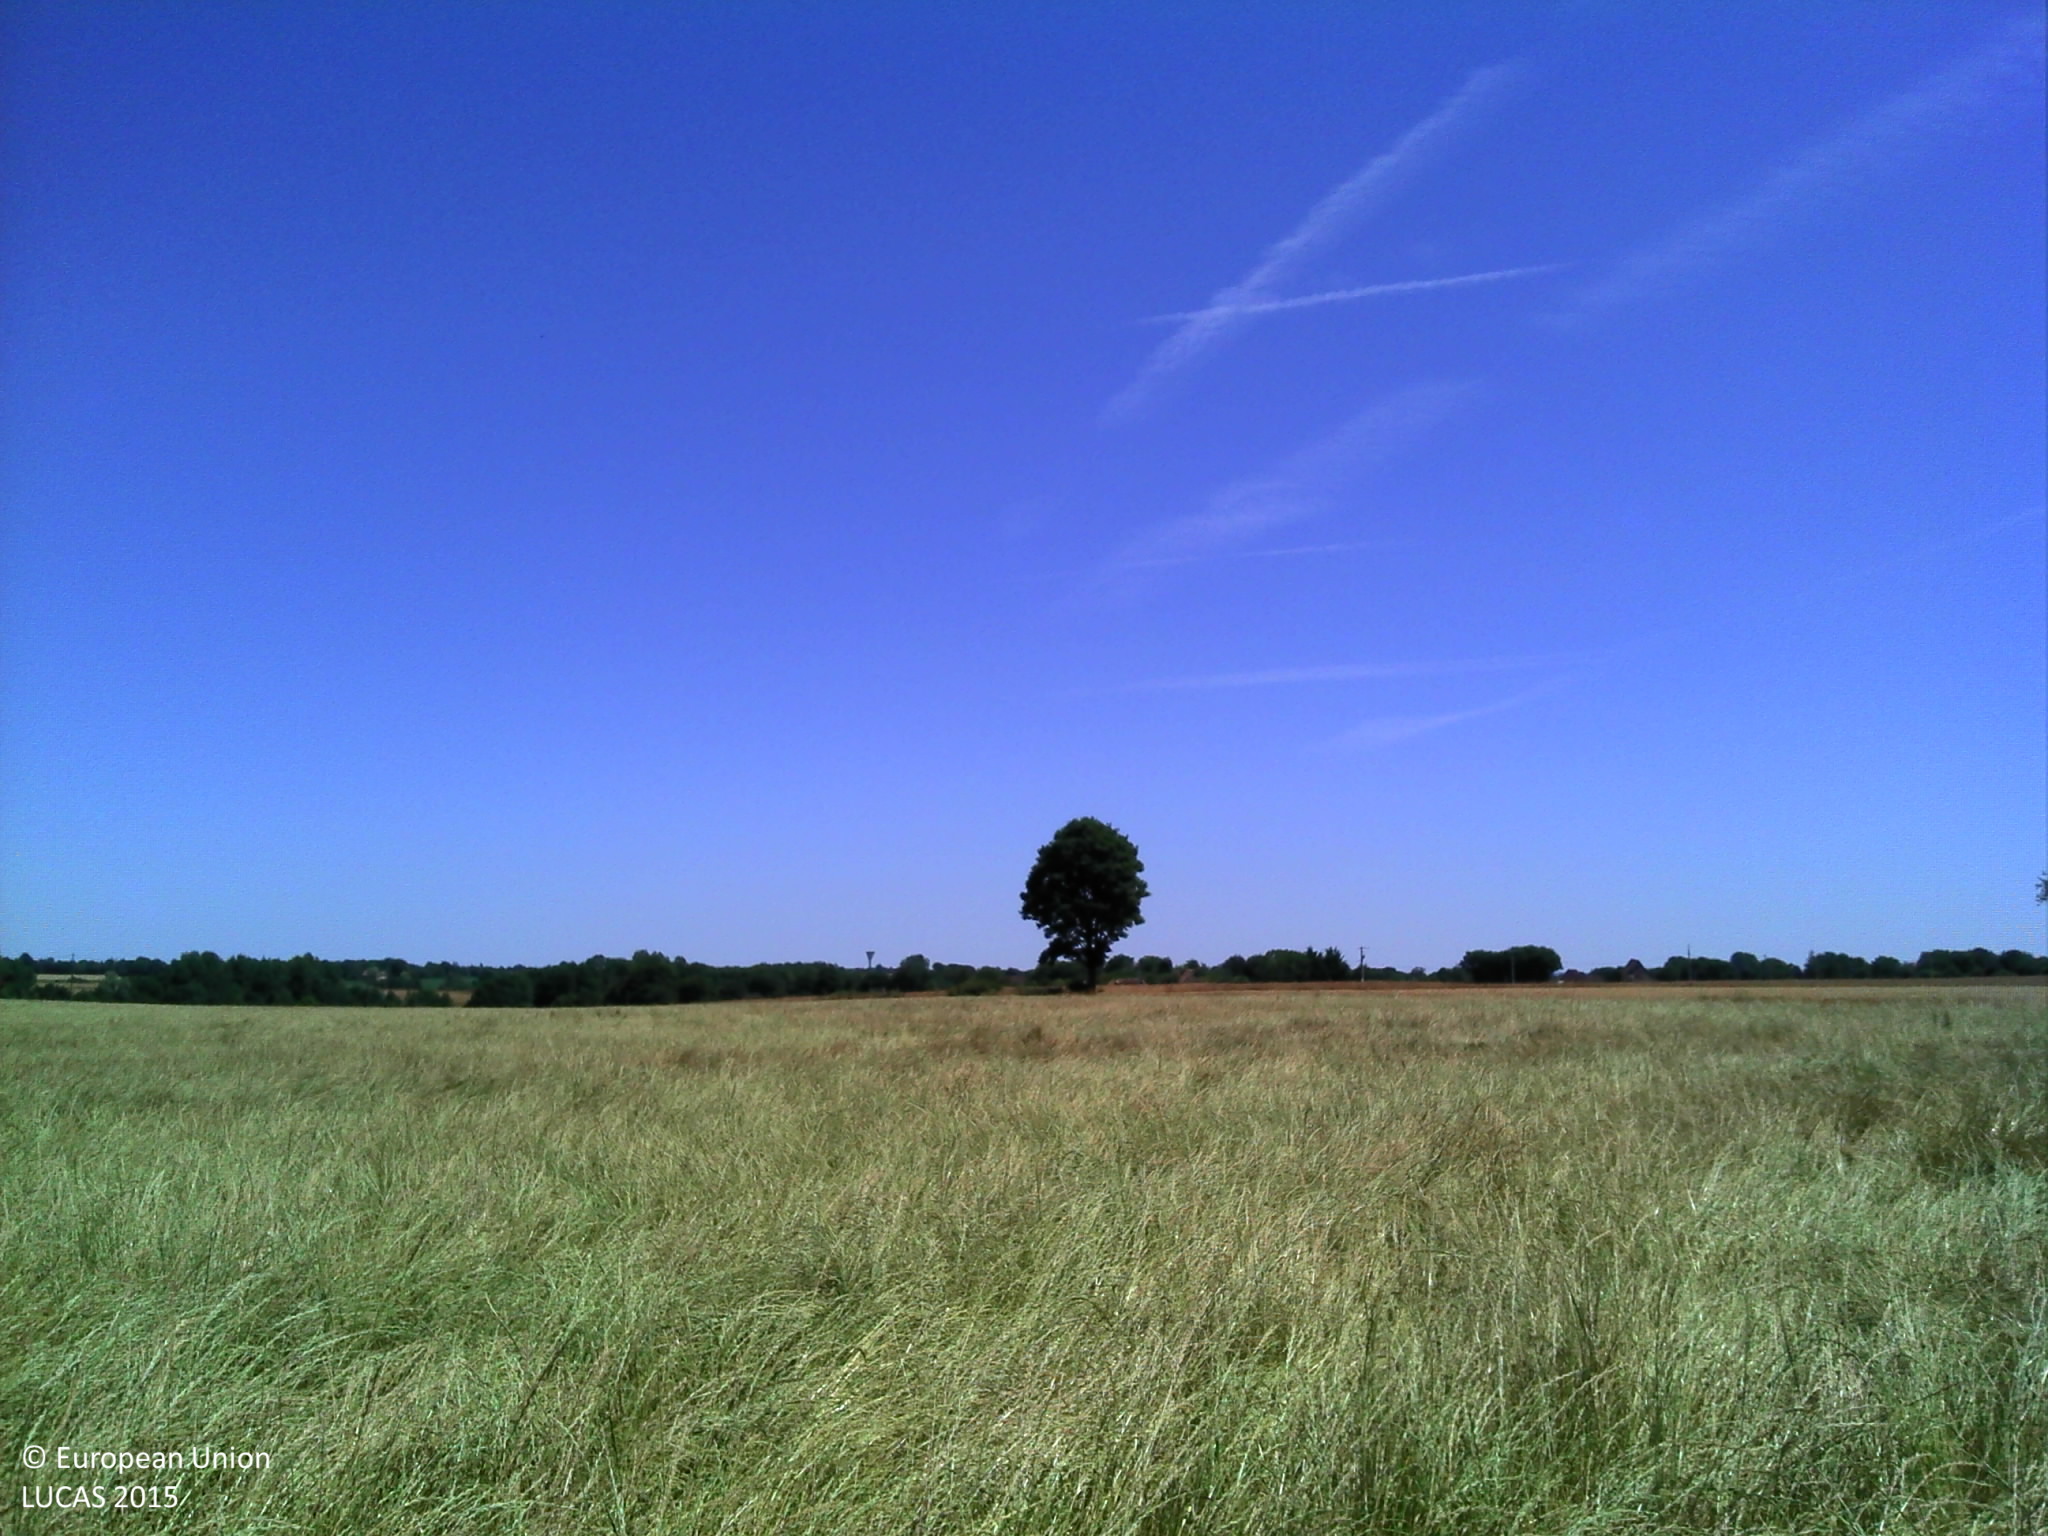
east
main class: Cropland
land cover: Durum wheat
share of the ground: > 75 %
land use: Agriculture (excluding fallow land and kitchen gardens)
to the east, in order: Durum wheat; Grassland without tree/shrub cover; Single bushes/trees; Rape and turnip rape
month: July
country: FR
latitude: 48.2146
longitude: 0.5420
